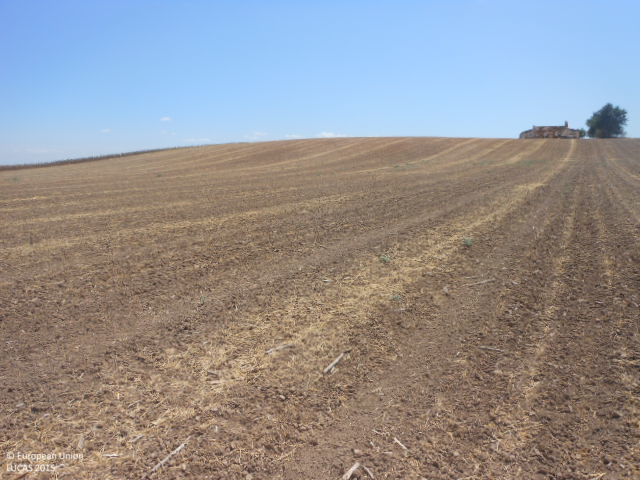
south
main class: Cropland
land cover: Dry pulses
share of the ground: < 10 %
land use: Agriculture (excluding fallow land and kitchen gardens)
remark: Harvested field
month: July
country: ES
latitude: 37.4246
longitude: -5.5093
